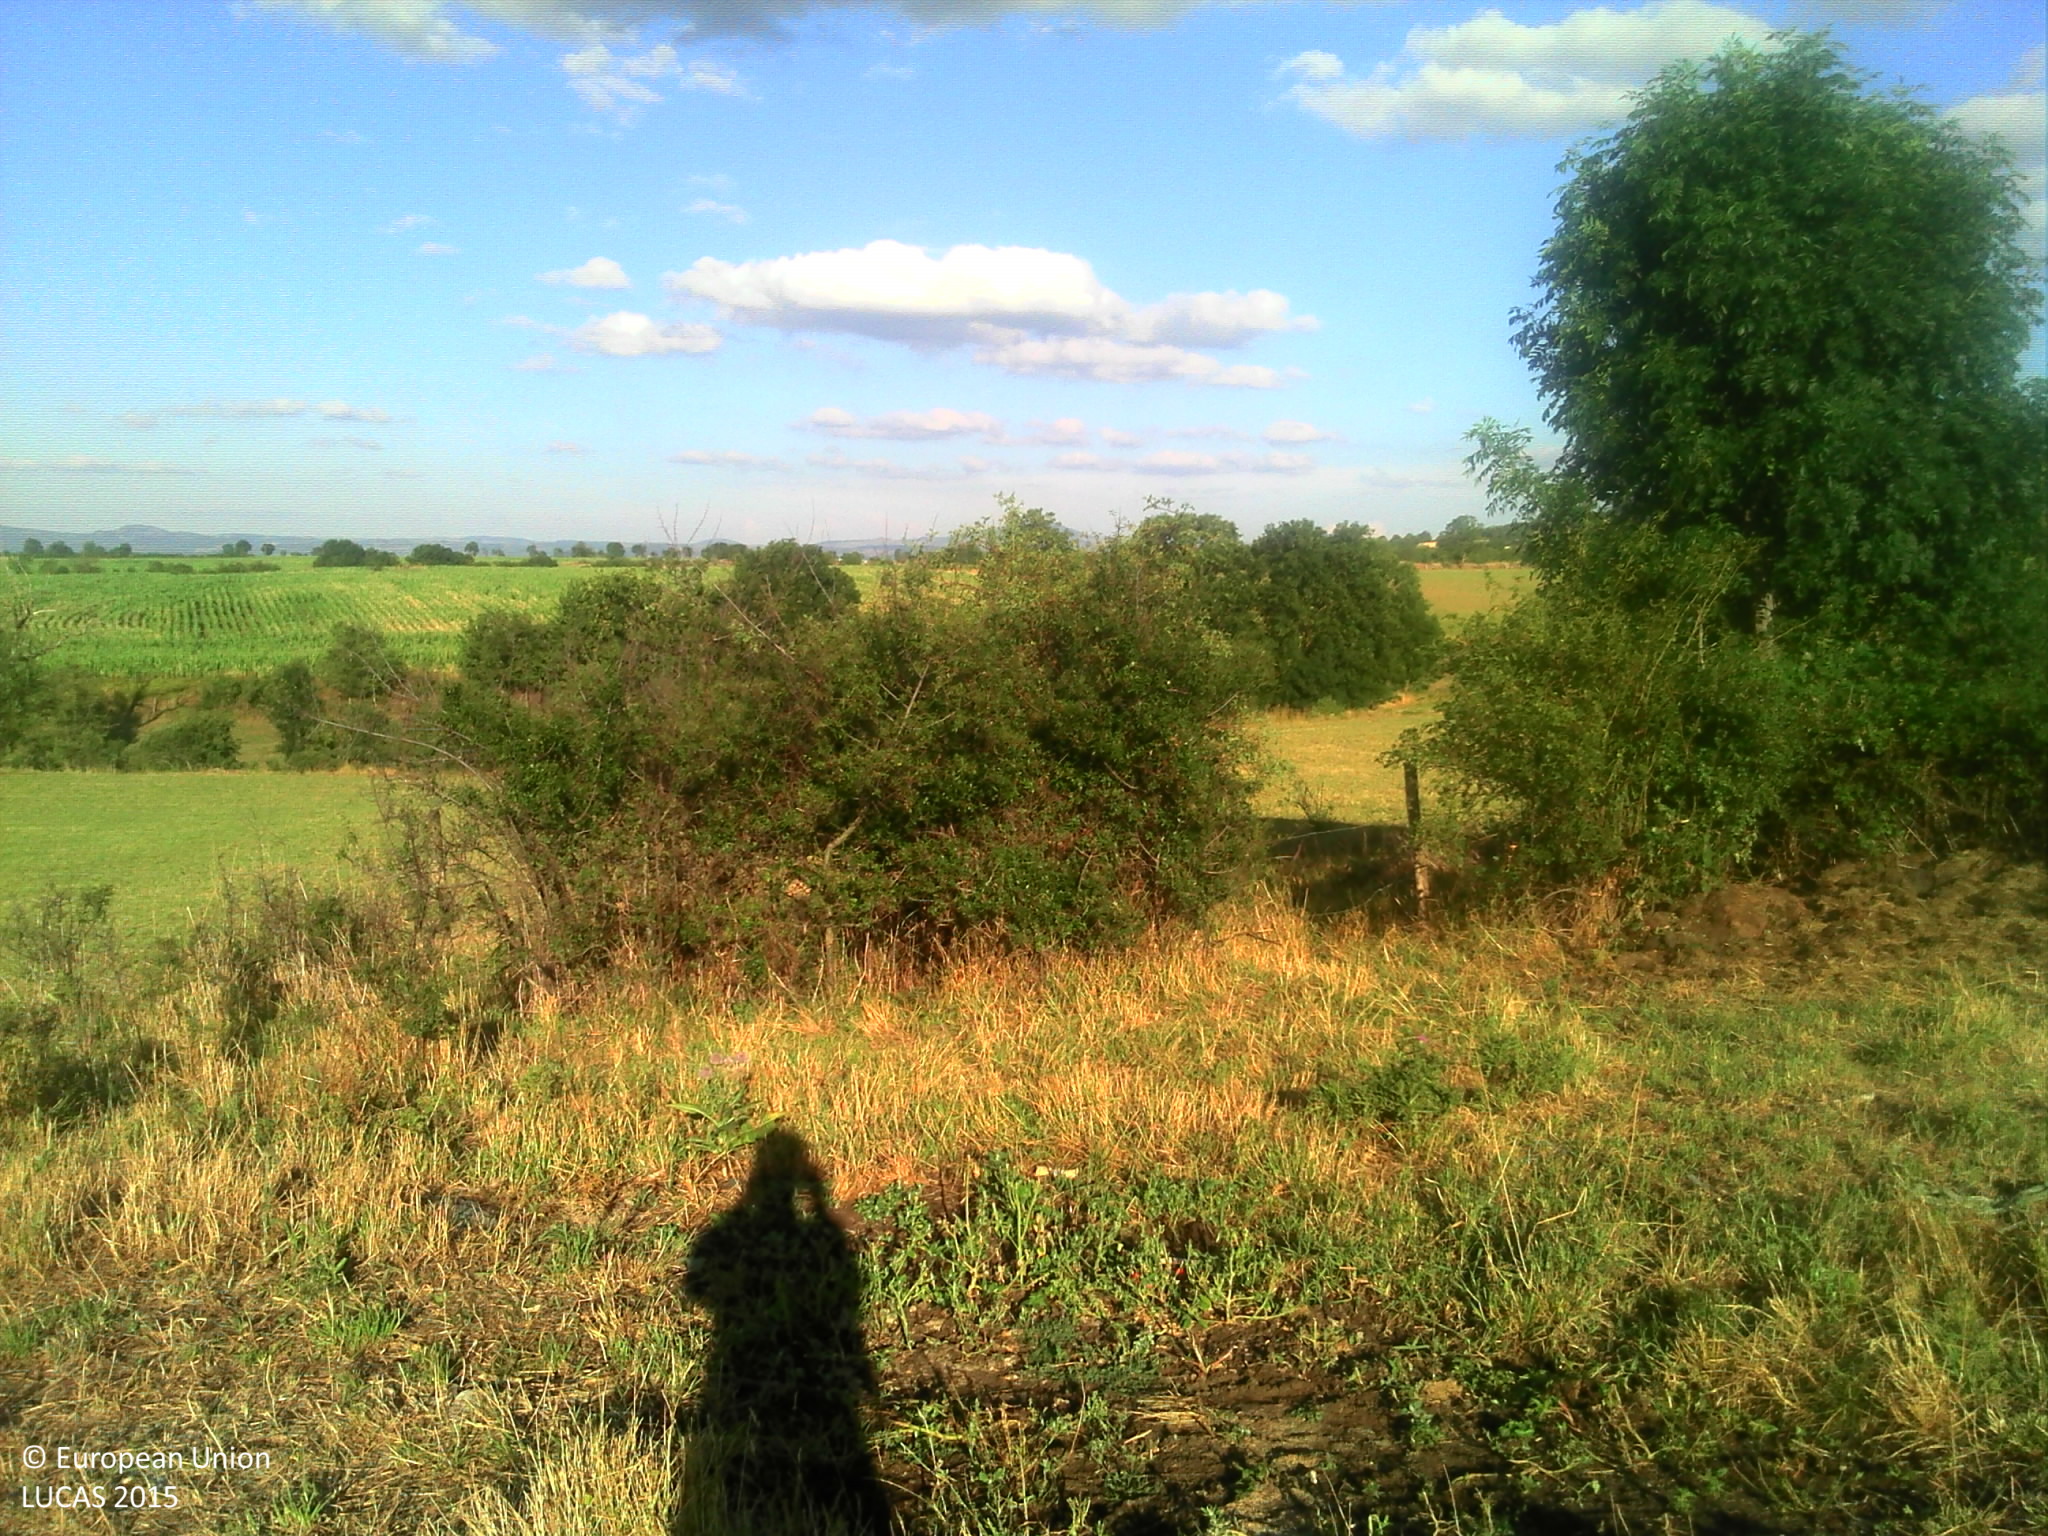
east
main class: Grassland
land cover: Grassland without tree/shrub cover
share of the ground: > 75 %
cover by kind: herbaceous plants 100 %
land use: Agriculture (excluding fallow land and kitchen gardens)
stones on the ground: < 10 %
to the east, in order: Grassland without tree/shrub cover; Managed hedges; Fences; Temporary grasslands; Abandoned hedges; Fences; Dry stone walls; Grassland without tree/shrub cover; Dry stone walls; Fences; Abandoned hedges; Grassland without tree/shrub cover; Dry stone walls; Fences; Abandoned hedges; Temporary grasslands
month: July
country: FR
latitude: 44.9984
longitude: 3.8263
